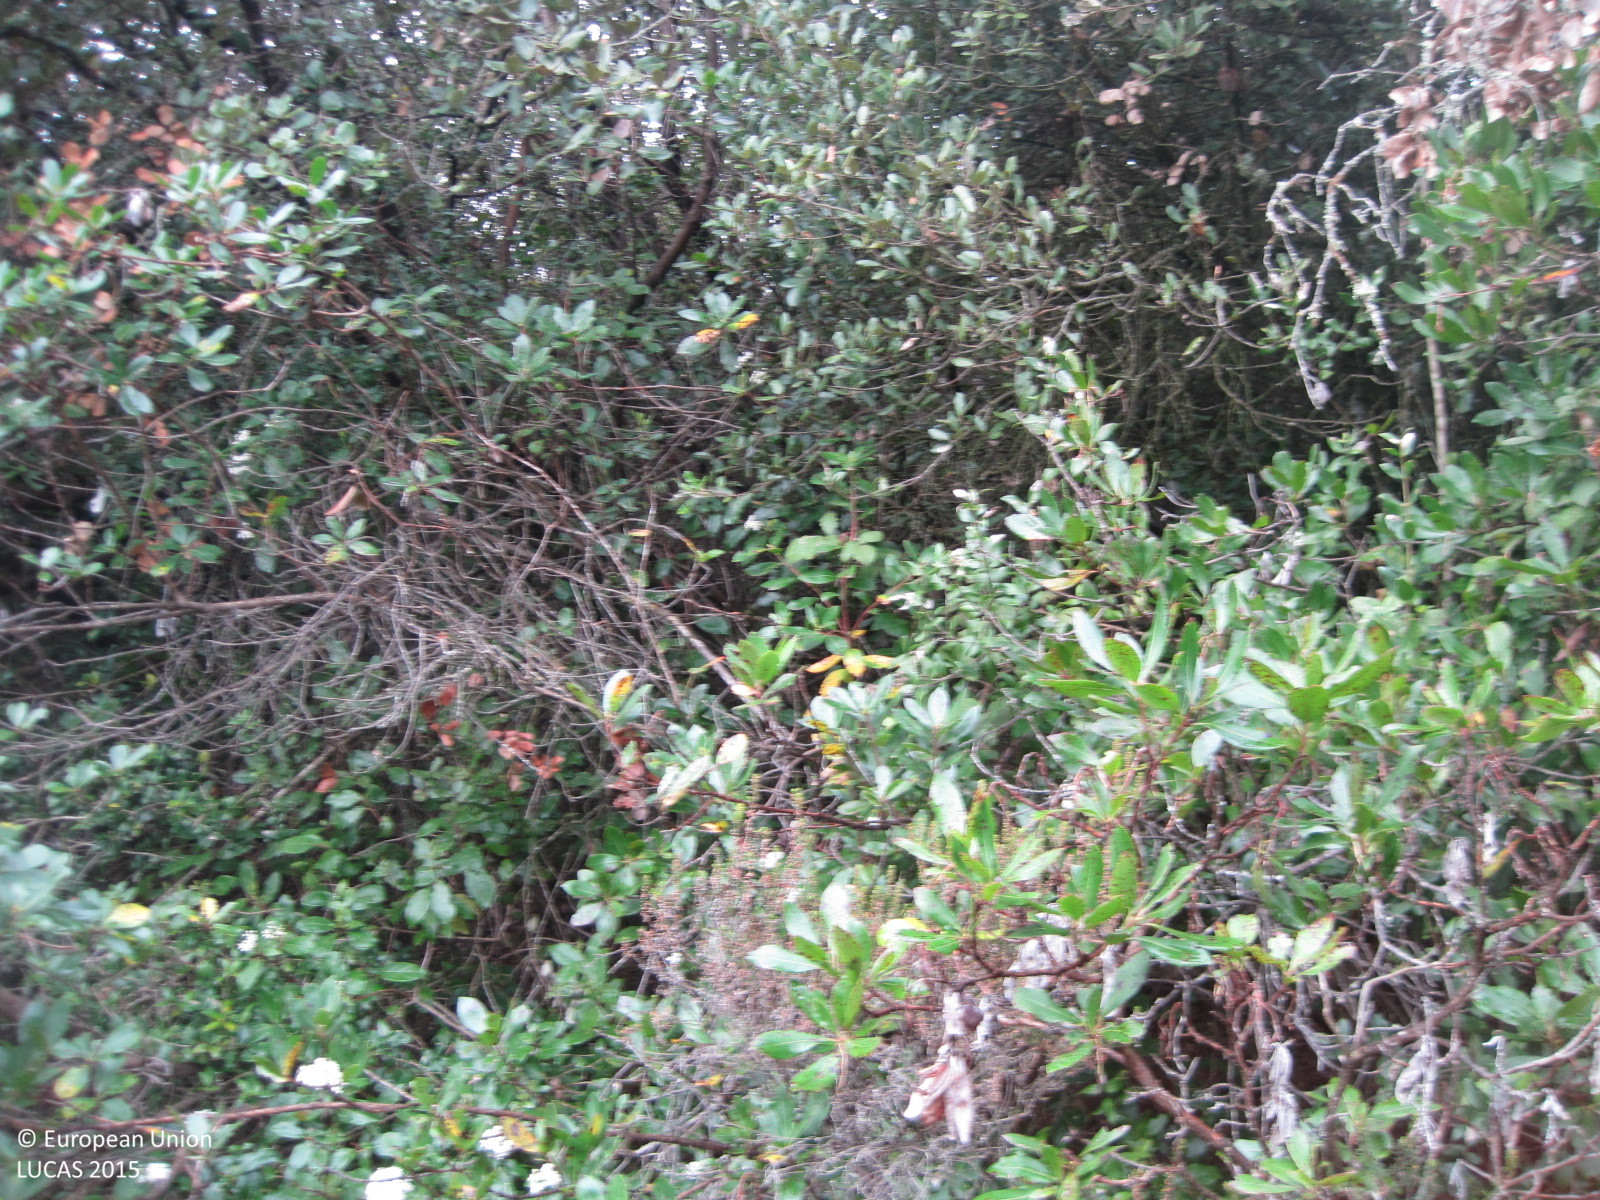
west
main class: Woodland
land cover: Broadleaved woodland
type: broadleaved evergreen forest
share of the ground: > 75 %
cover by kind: broadleaved forest trees 100 %
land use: Forestry
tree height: > 5 m
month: April
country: ES
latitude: 42.6784
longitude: -2.2107
